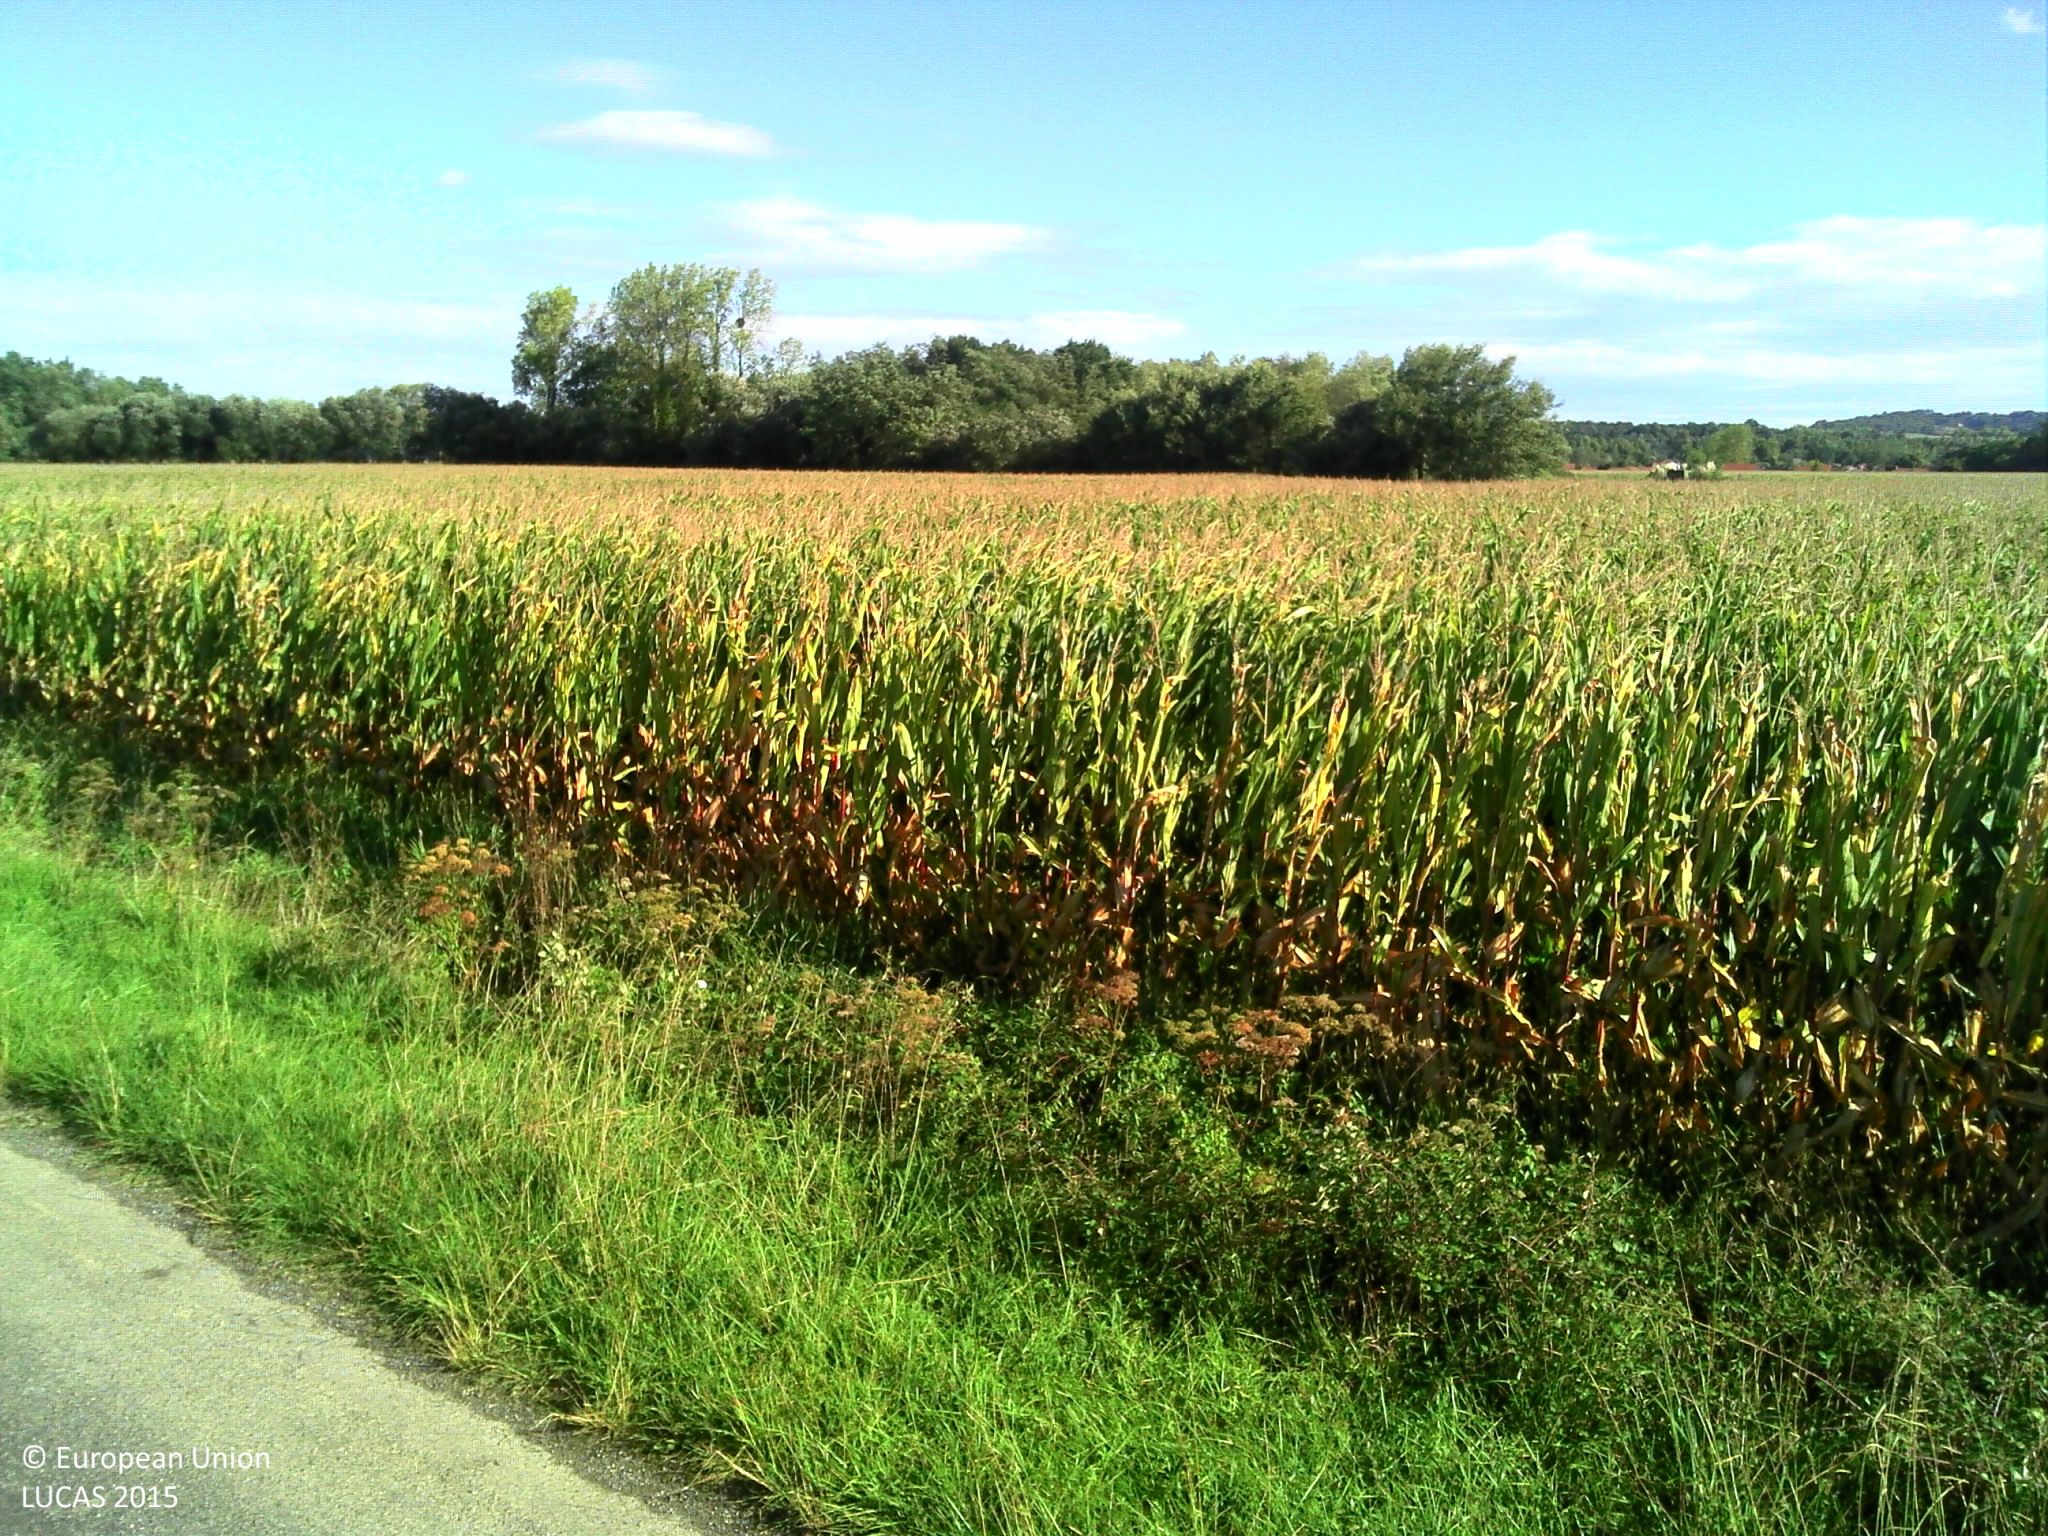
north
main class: Cropland
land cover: Maize
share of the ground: > 75 %
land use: Agriculture (excluding fallow land and kitchen gardens)
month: September
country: FR
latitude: 43.4477
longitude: -0.7241
